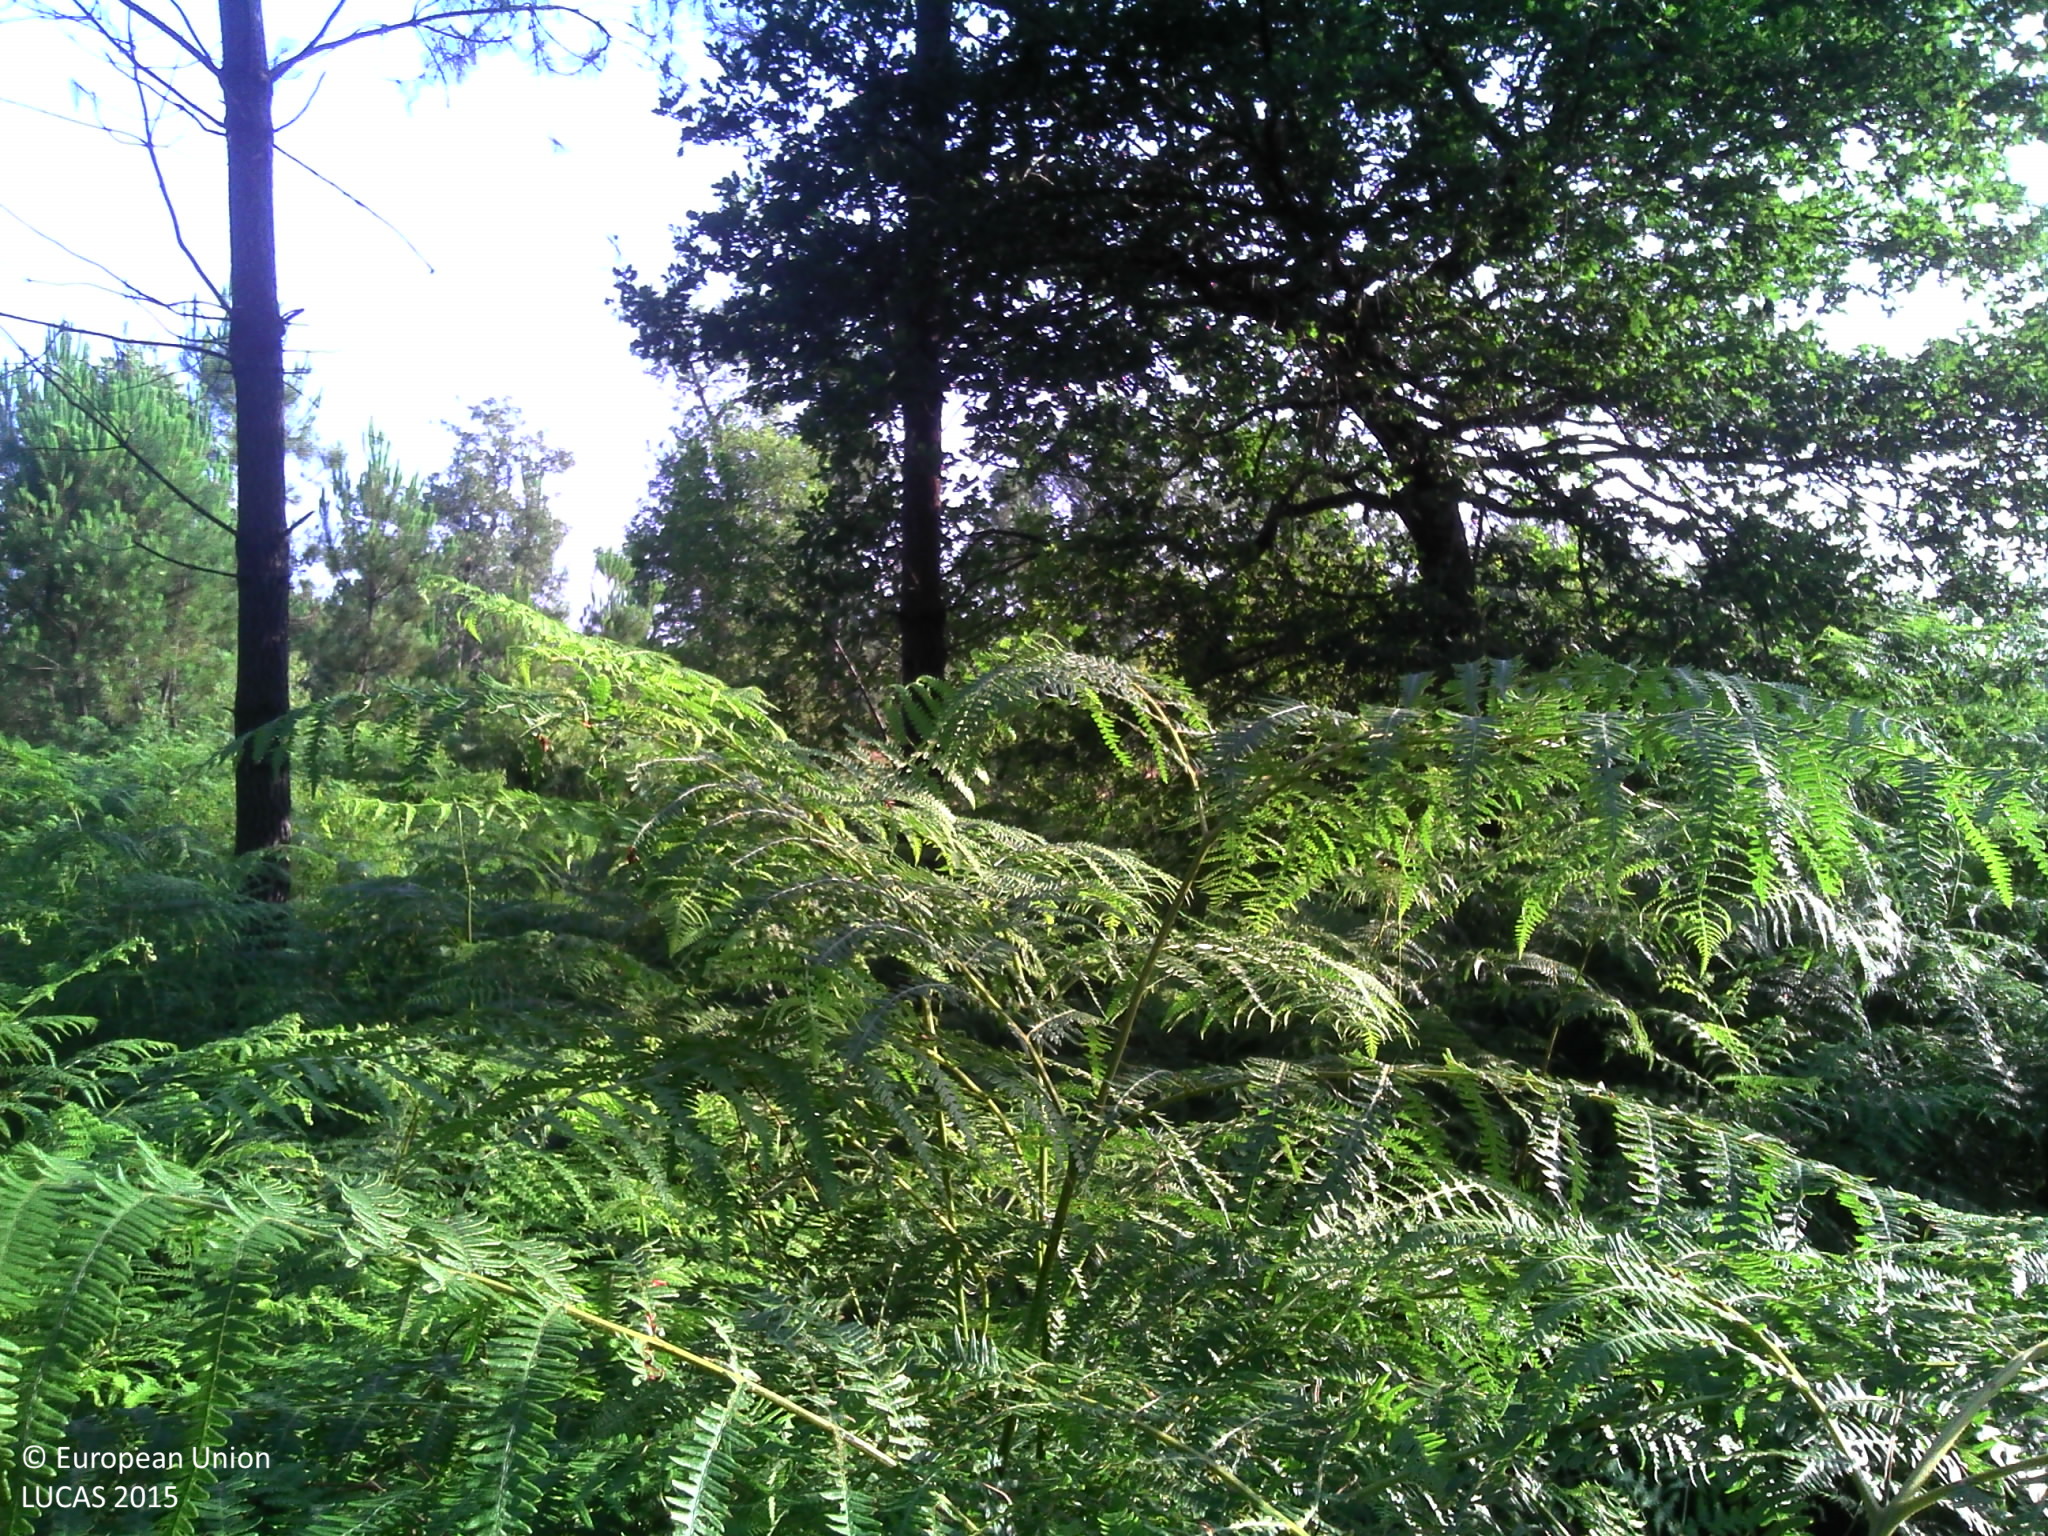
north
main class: Woodland
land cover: Pine dominated coniferous woodland
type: coniferous forest of the mediterranean region
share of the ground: > 75 %
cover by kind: coniferous forest trees 60 %, herbaceous plants 40 %
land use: Forestry
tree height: > 5 m
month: July
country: FR
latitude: 44.1179
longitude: -0.5728
